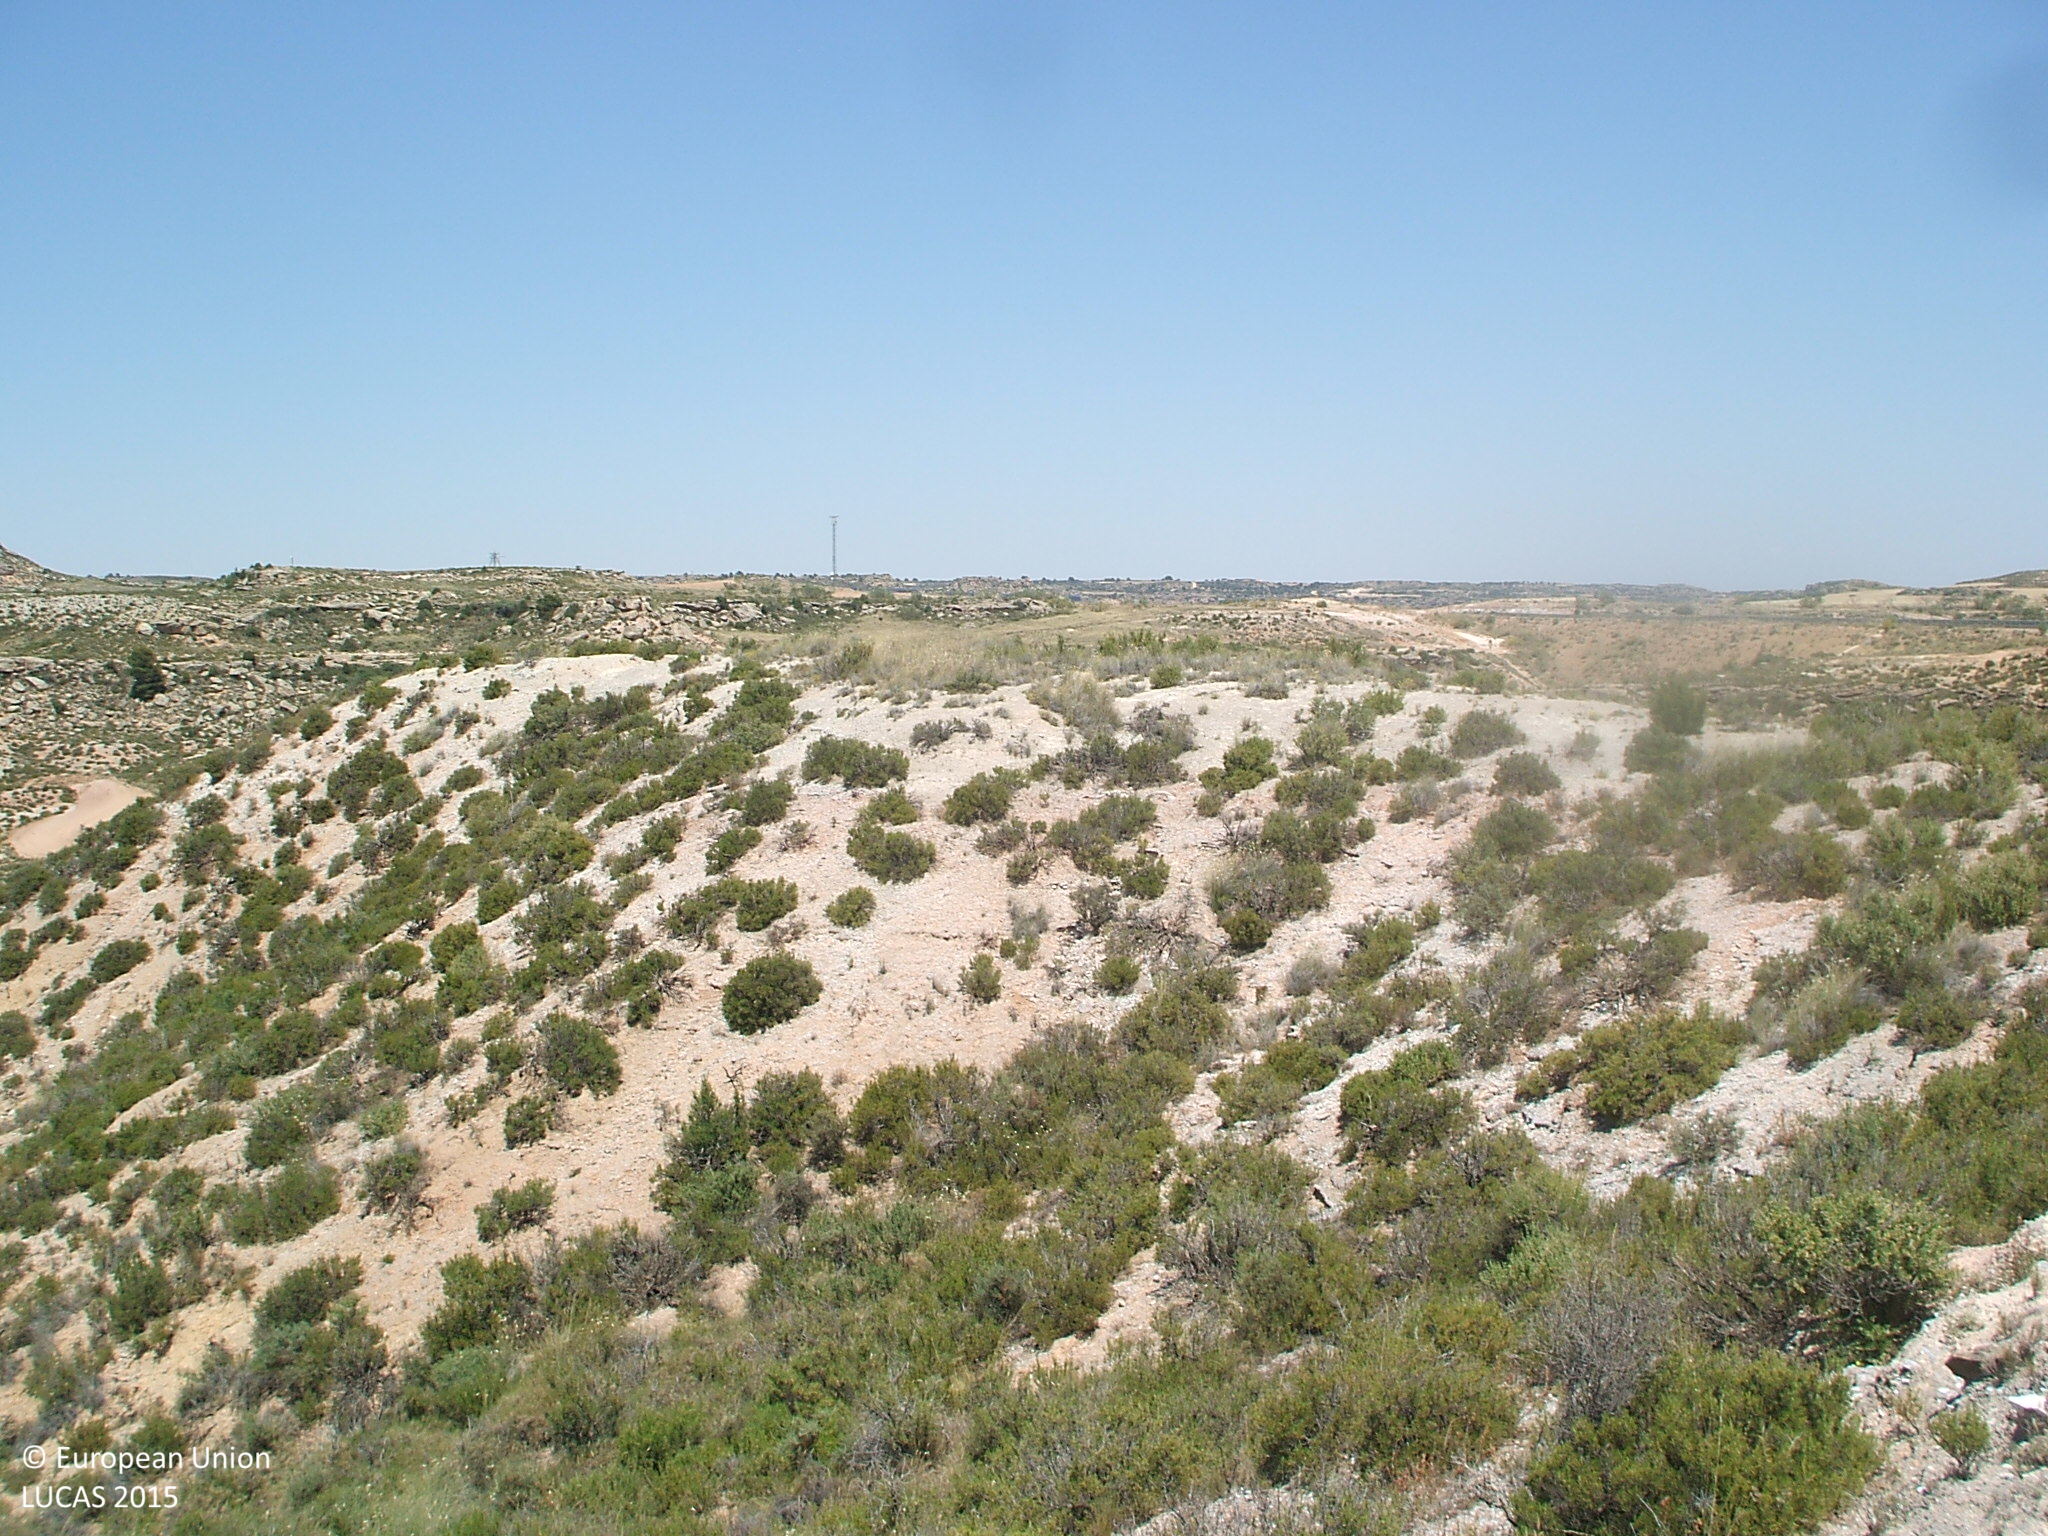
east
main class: Shrubland
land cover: Shrubland without tree cover
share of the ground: 10 - 25 %
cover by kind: consolidated bare surface 80 %, shrubs 20 %
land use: Semi-natural and natural areas not in use
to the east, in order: Shrubland without tree cover; Sand; Rock outcrops; Shrubland without tree cover; Barley; Shrubland without tree cover; Artificial constructions in urban areas; Fences; Paved roads, cycling and walking lanes
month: June
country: ES
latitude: 41.0834
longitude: -0.1895
